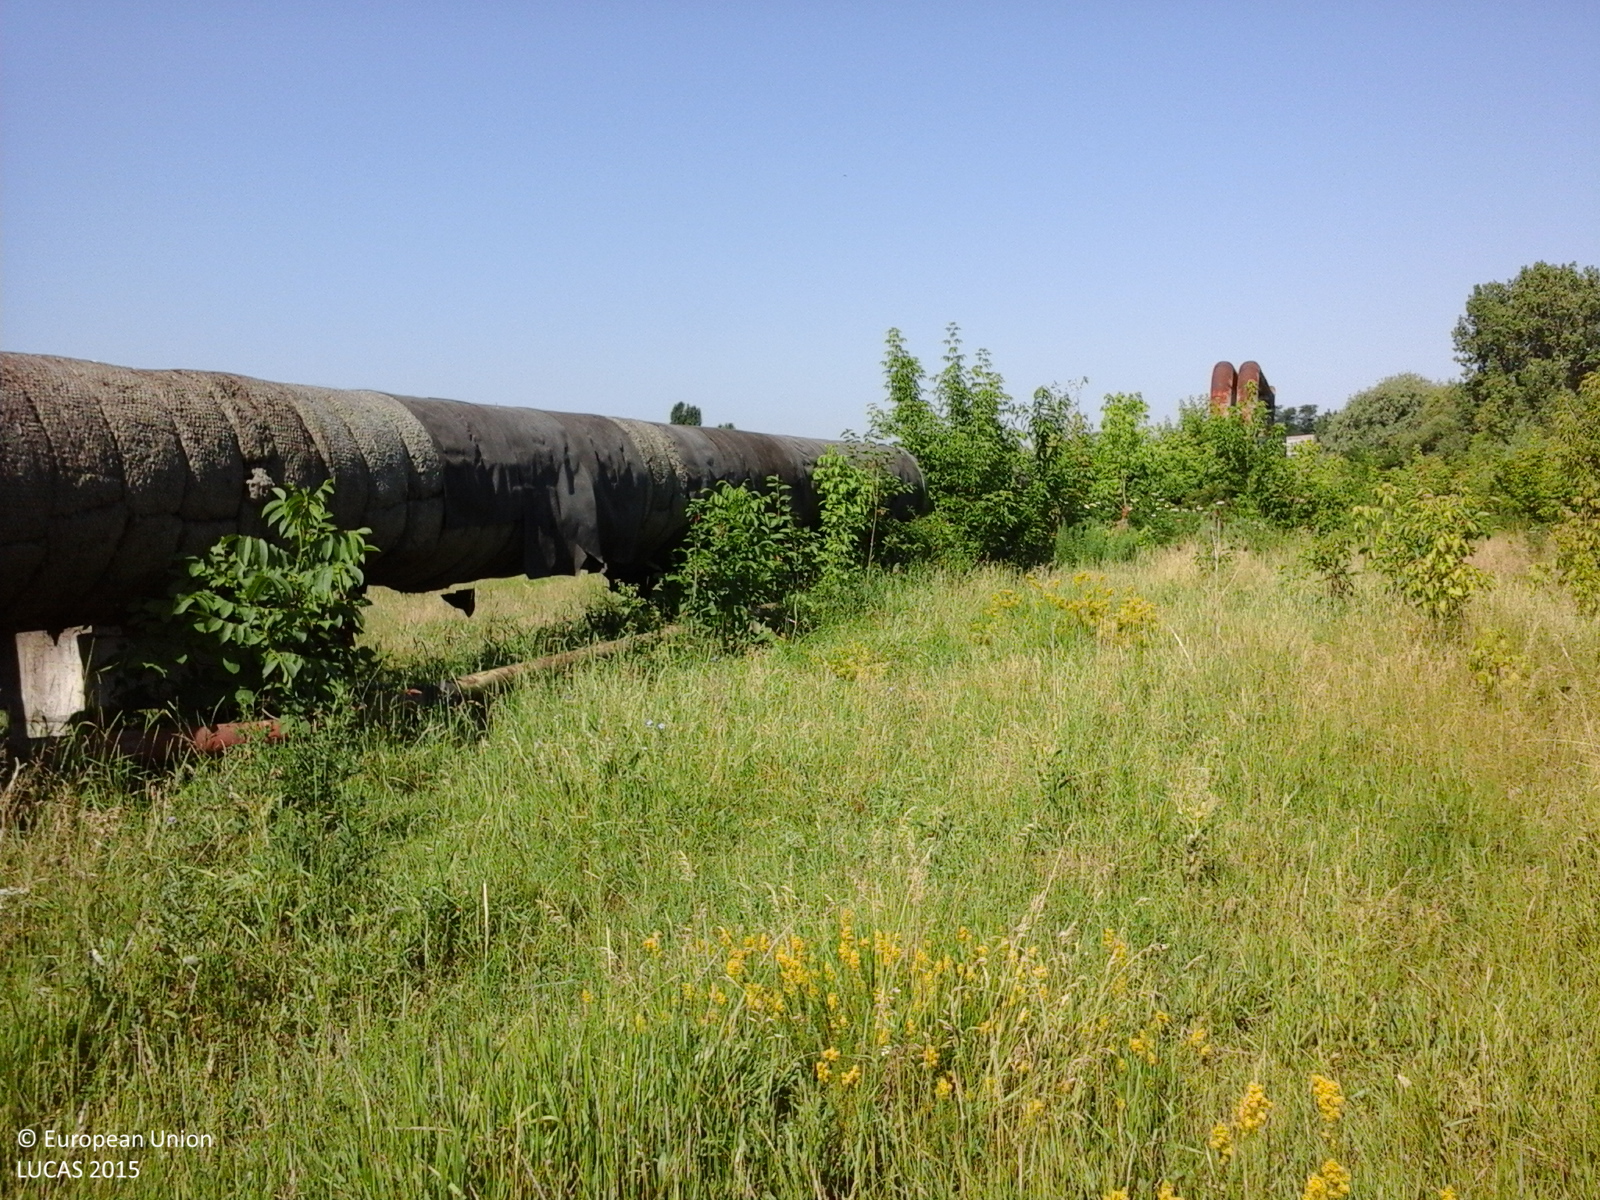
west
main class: Grassland
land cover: Grassland with sparse tree/shrub cover
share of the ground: > 75 %
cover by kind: herbaceous plants 90 %, broadleaved forest trees 5 %, shrubs 5 %
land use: Semi-natural and natural areas not in use
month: June
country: RO
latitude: 47.1527
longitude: 27.6481
